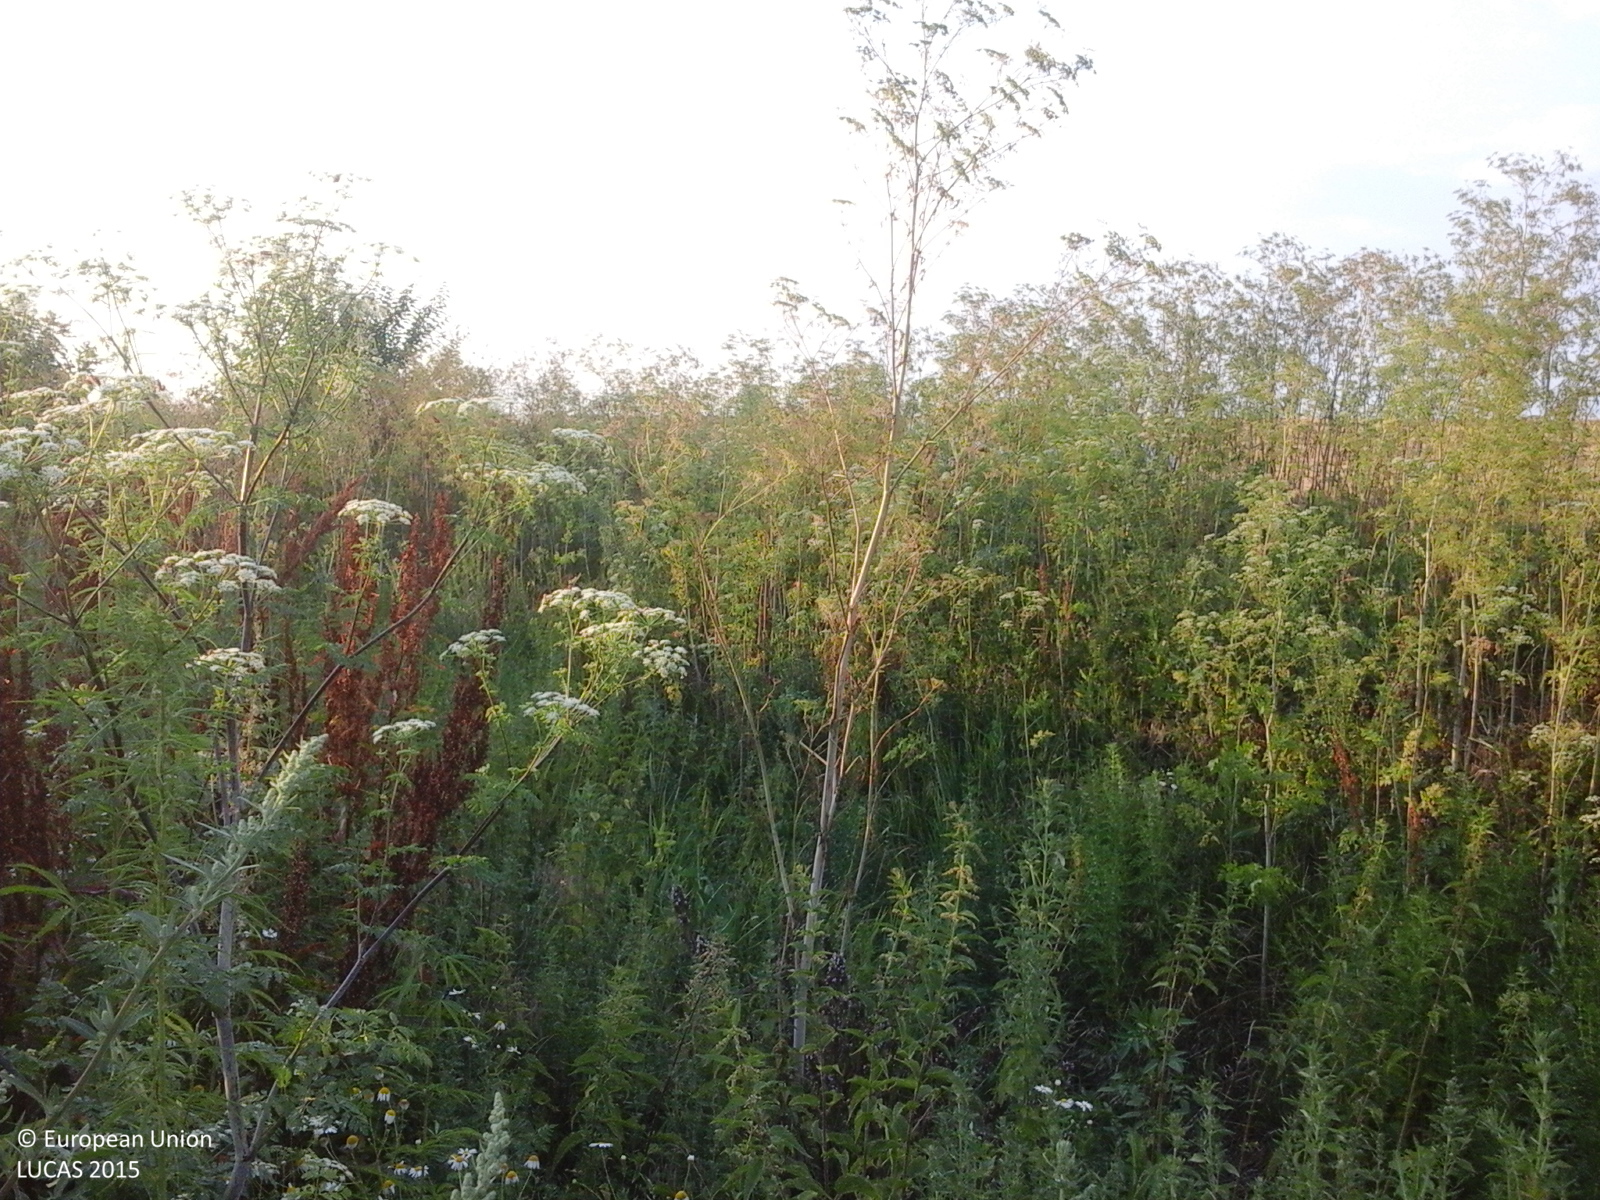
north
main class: Cropland
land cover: Sunflower
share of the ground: > 75 %
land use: Agriculture (excluding fallow land and kitchen gardens)
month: July
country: RO
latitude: 44.1123
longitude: 25.9793
